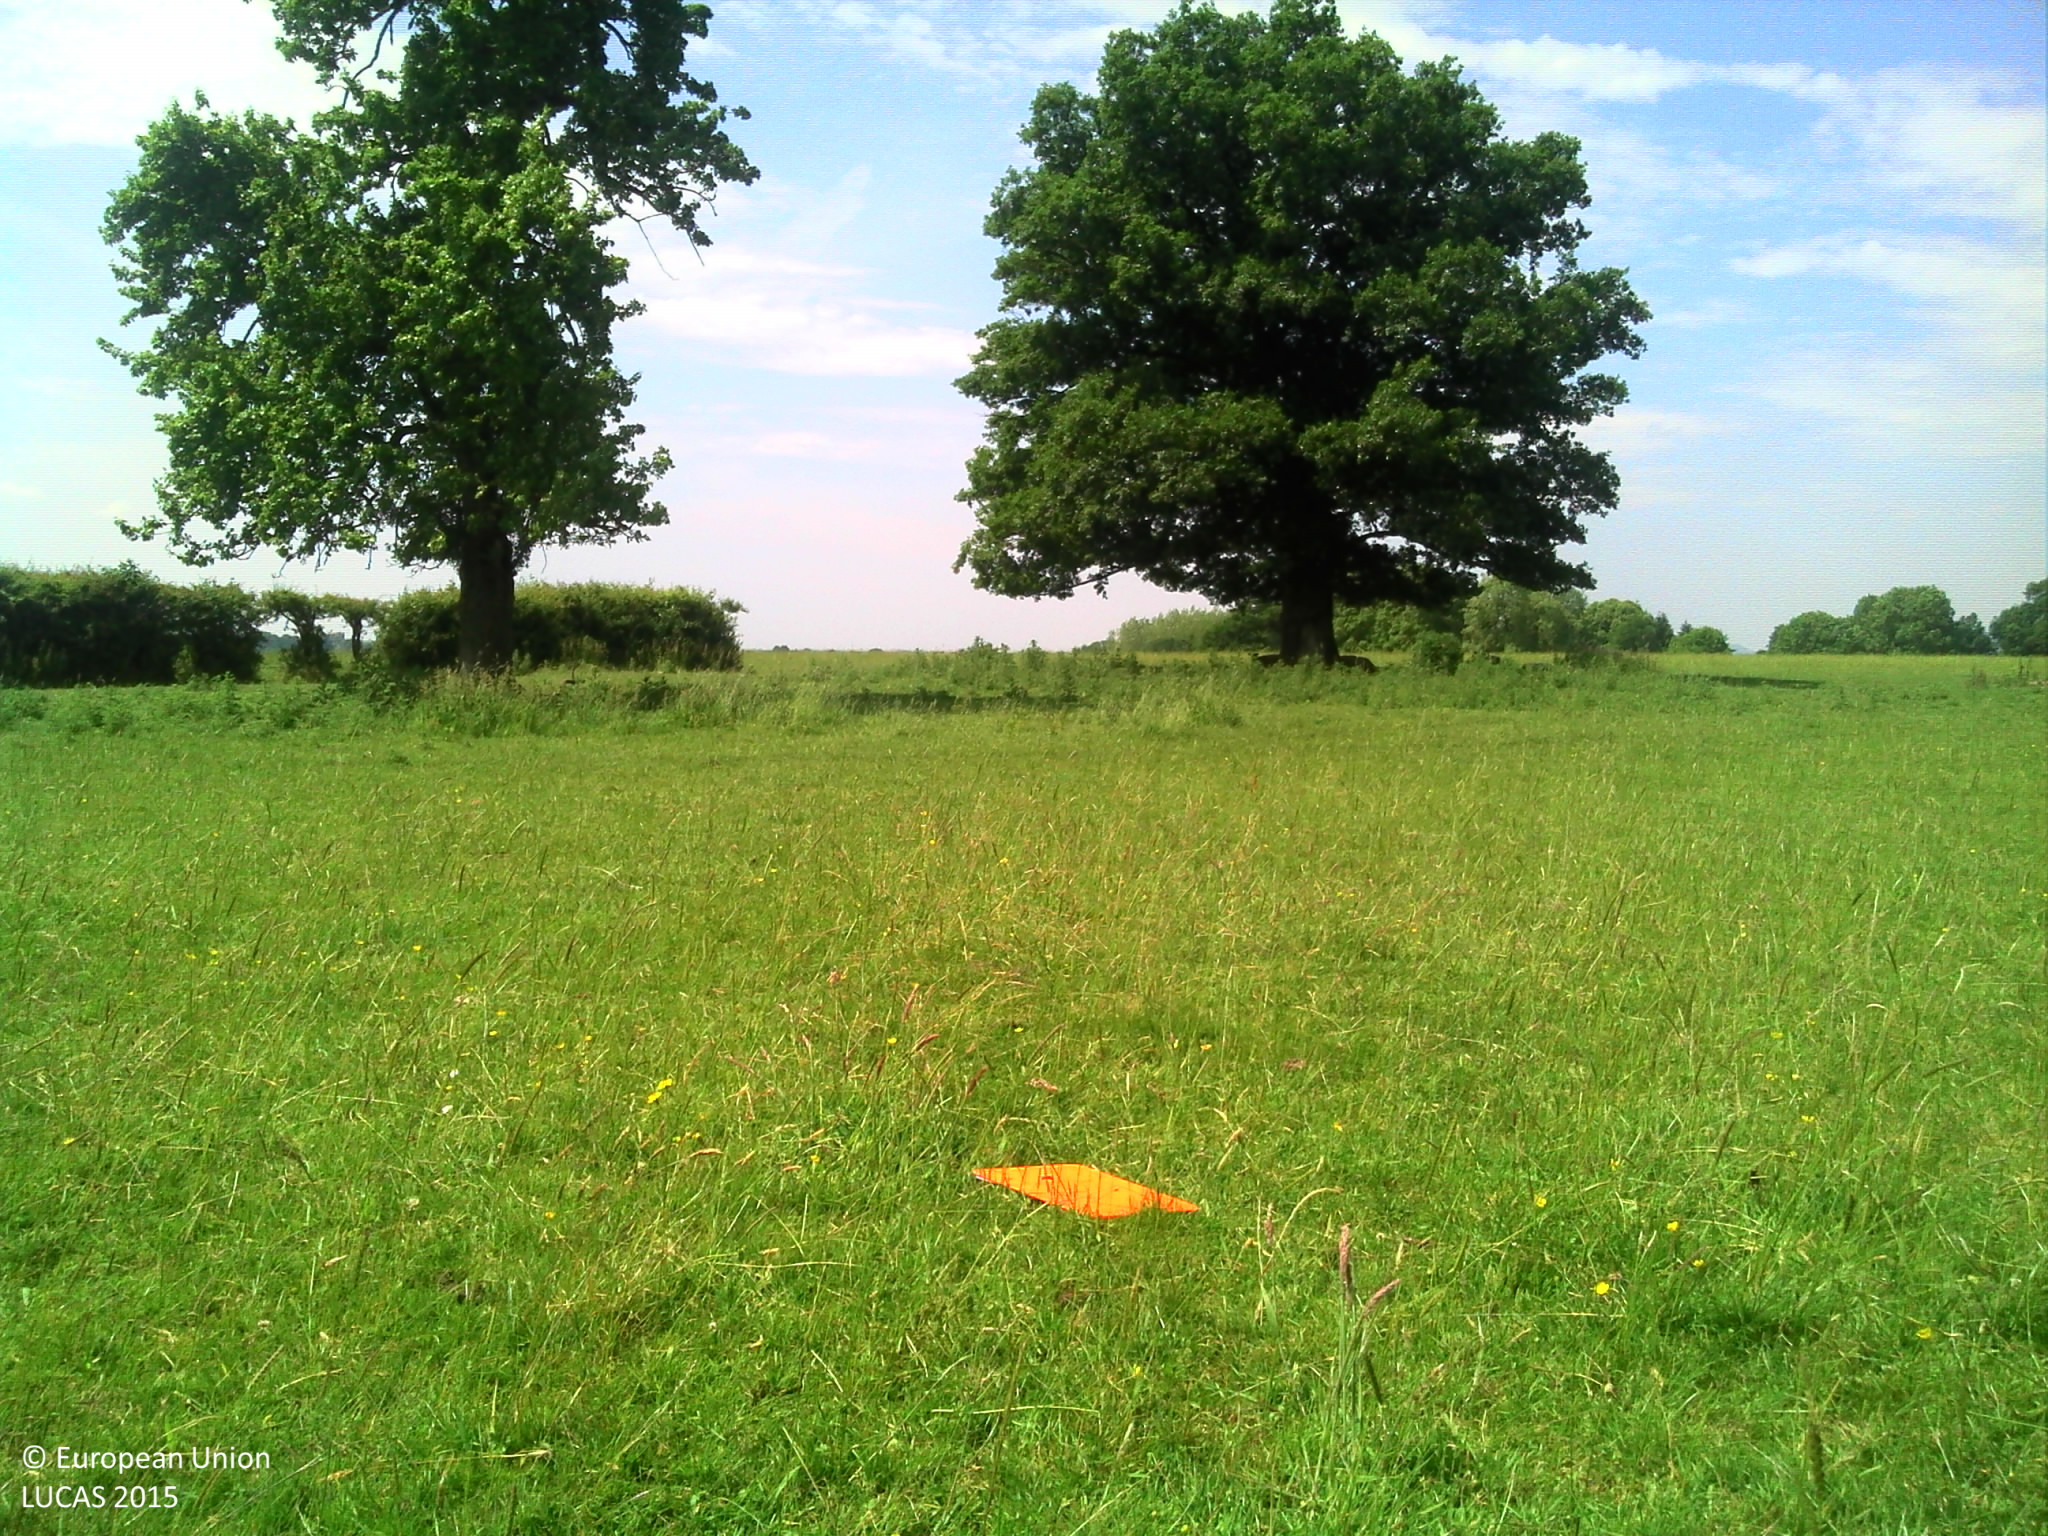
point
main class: Grassland
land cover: Grassland without tree/shrub cover
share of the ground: > 75 %
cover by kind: herbaceous plants 95 %
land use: Agriculture (excluding fallow land and kitchen gardens)
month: June
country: FR
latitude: 48.5096
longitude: 0.1855
